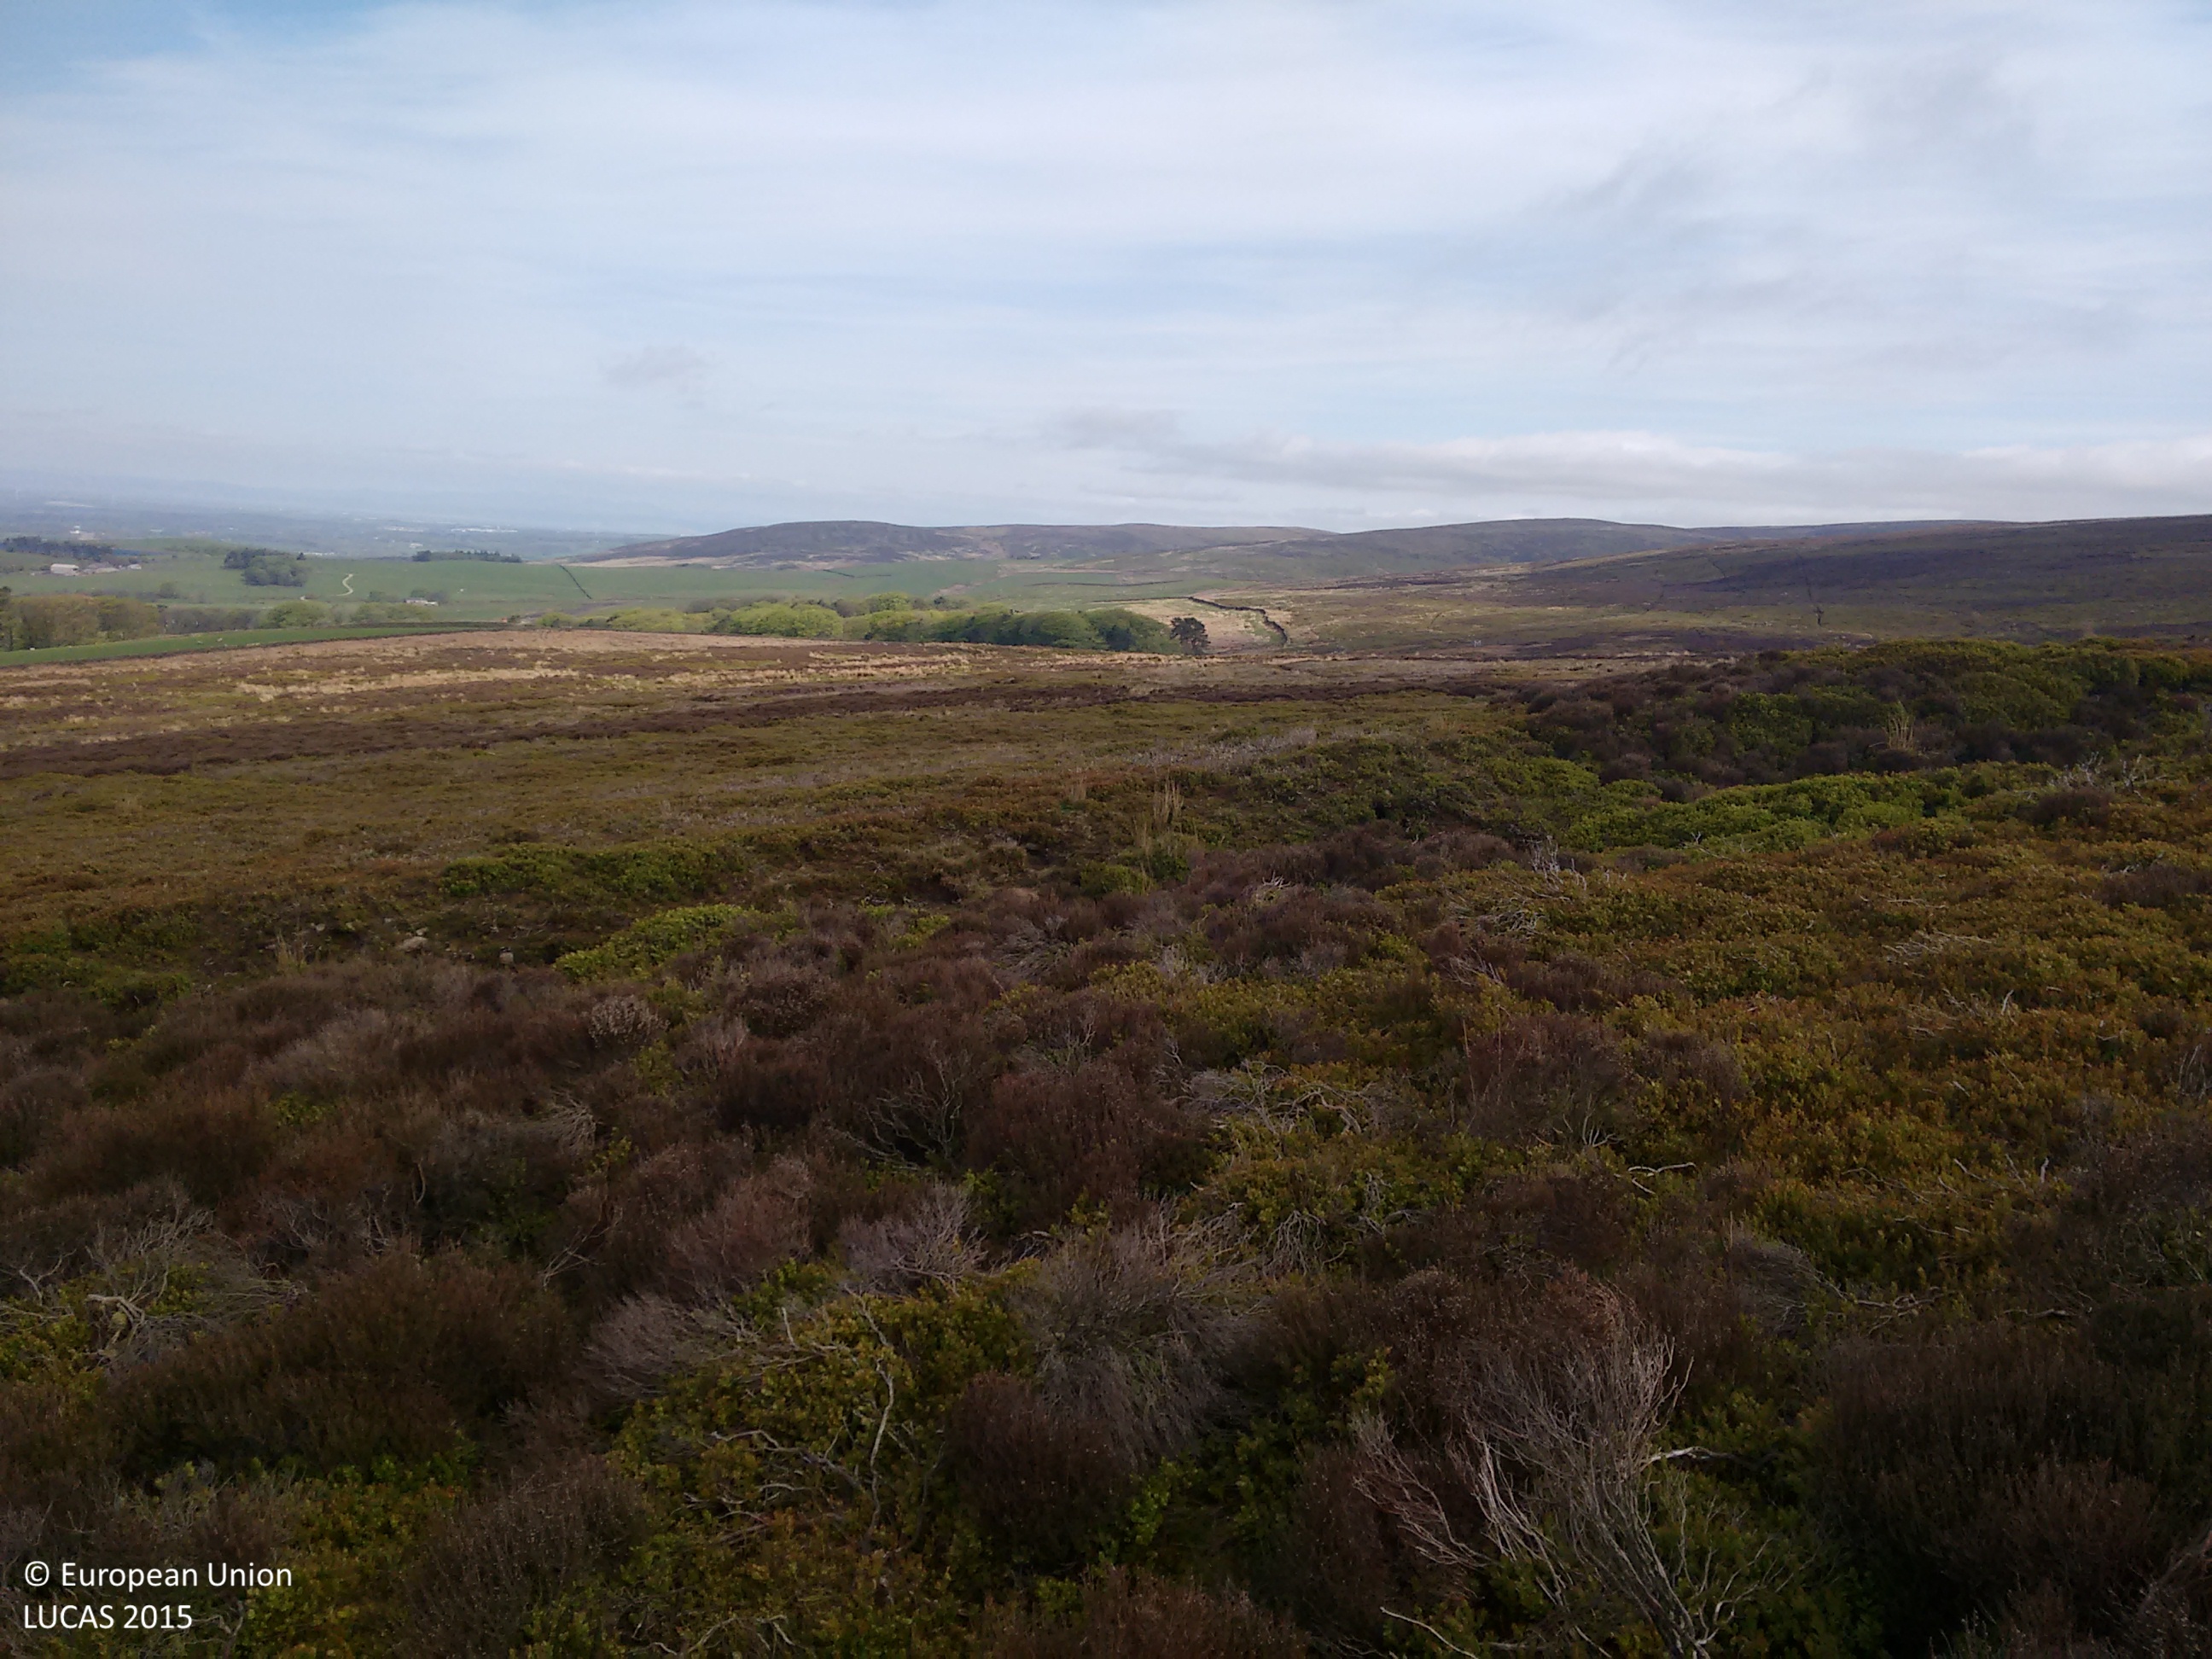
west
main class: Shrubland
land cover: Shrubland without tree cover
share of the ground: > 75 %
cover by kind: shrubs 100 %
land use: Agriculture (excluding fallow land and kitchen gardens)
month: May
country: GB
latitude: 53.9148
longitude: -2.6892
